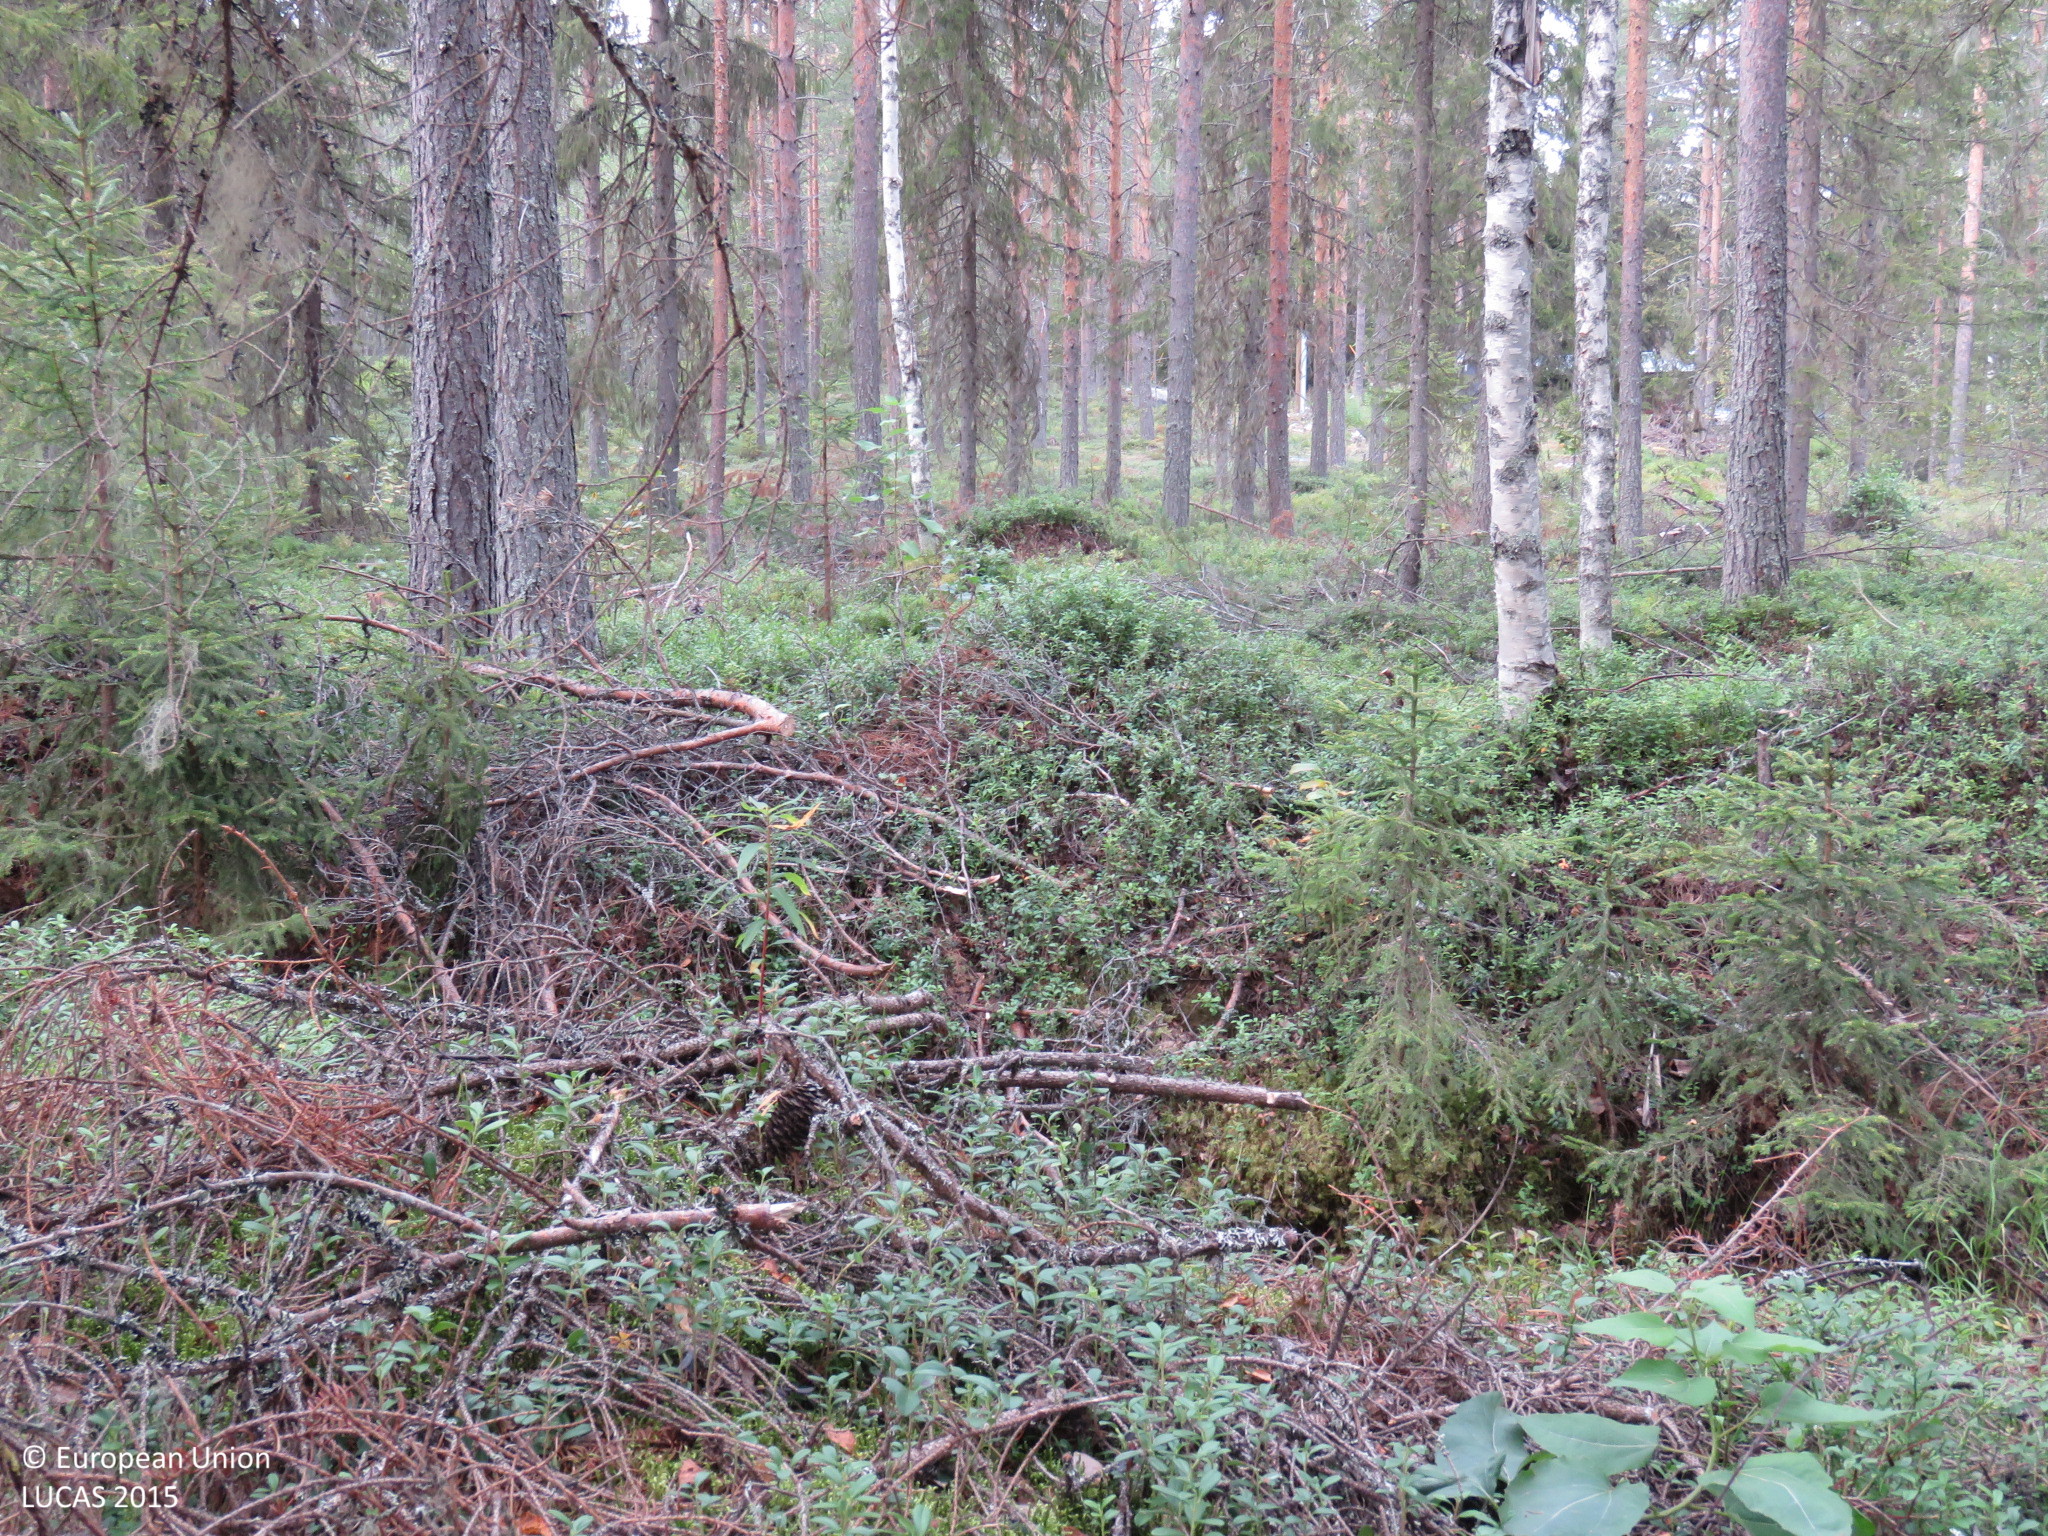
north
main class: Woodland
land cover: Other coniferous woodland
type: boreal forest
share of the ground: > 75 %
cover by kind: coniferous forest trees 60 %, broadleaved forest trees 15 %, shrubs 15 %, lichens and mosses 5 %
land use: Forestry
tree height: > 5 m
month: August
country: FI
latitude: 65.0556
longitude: 26.2298
